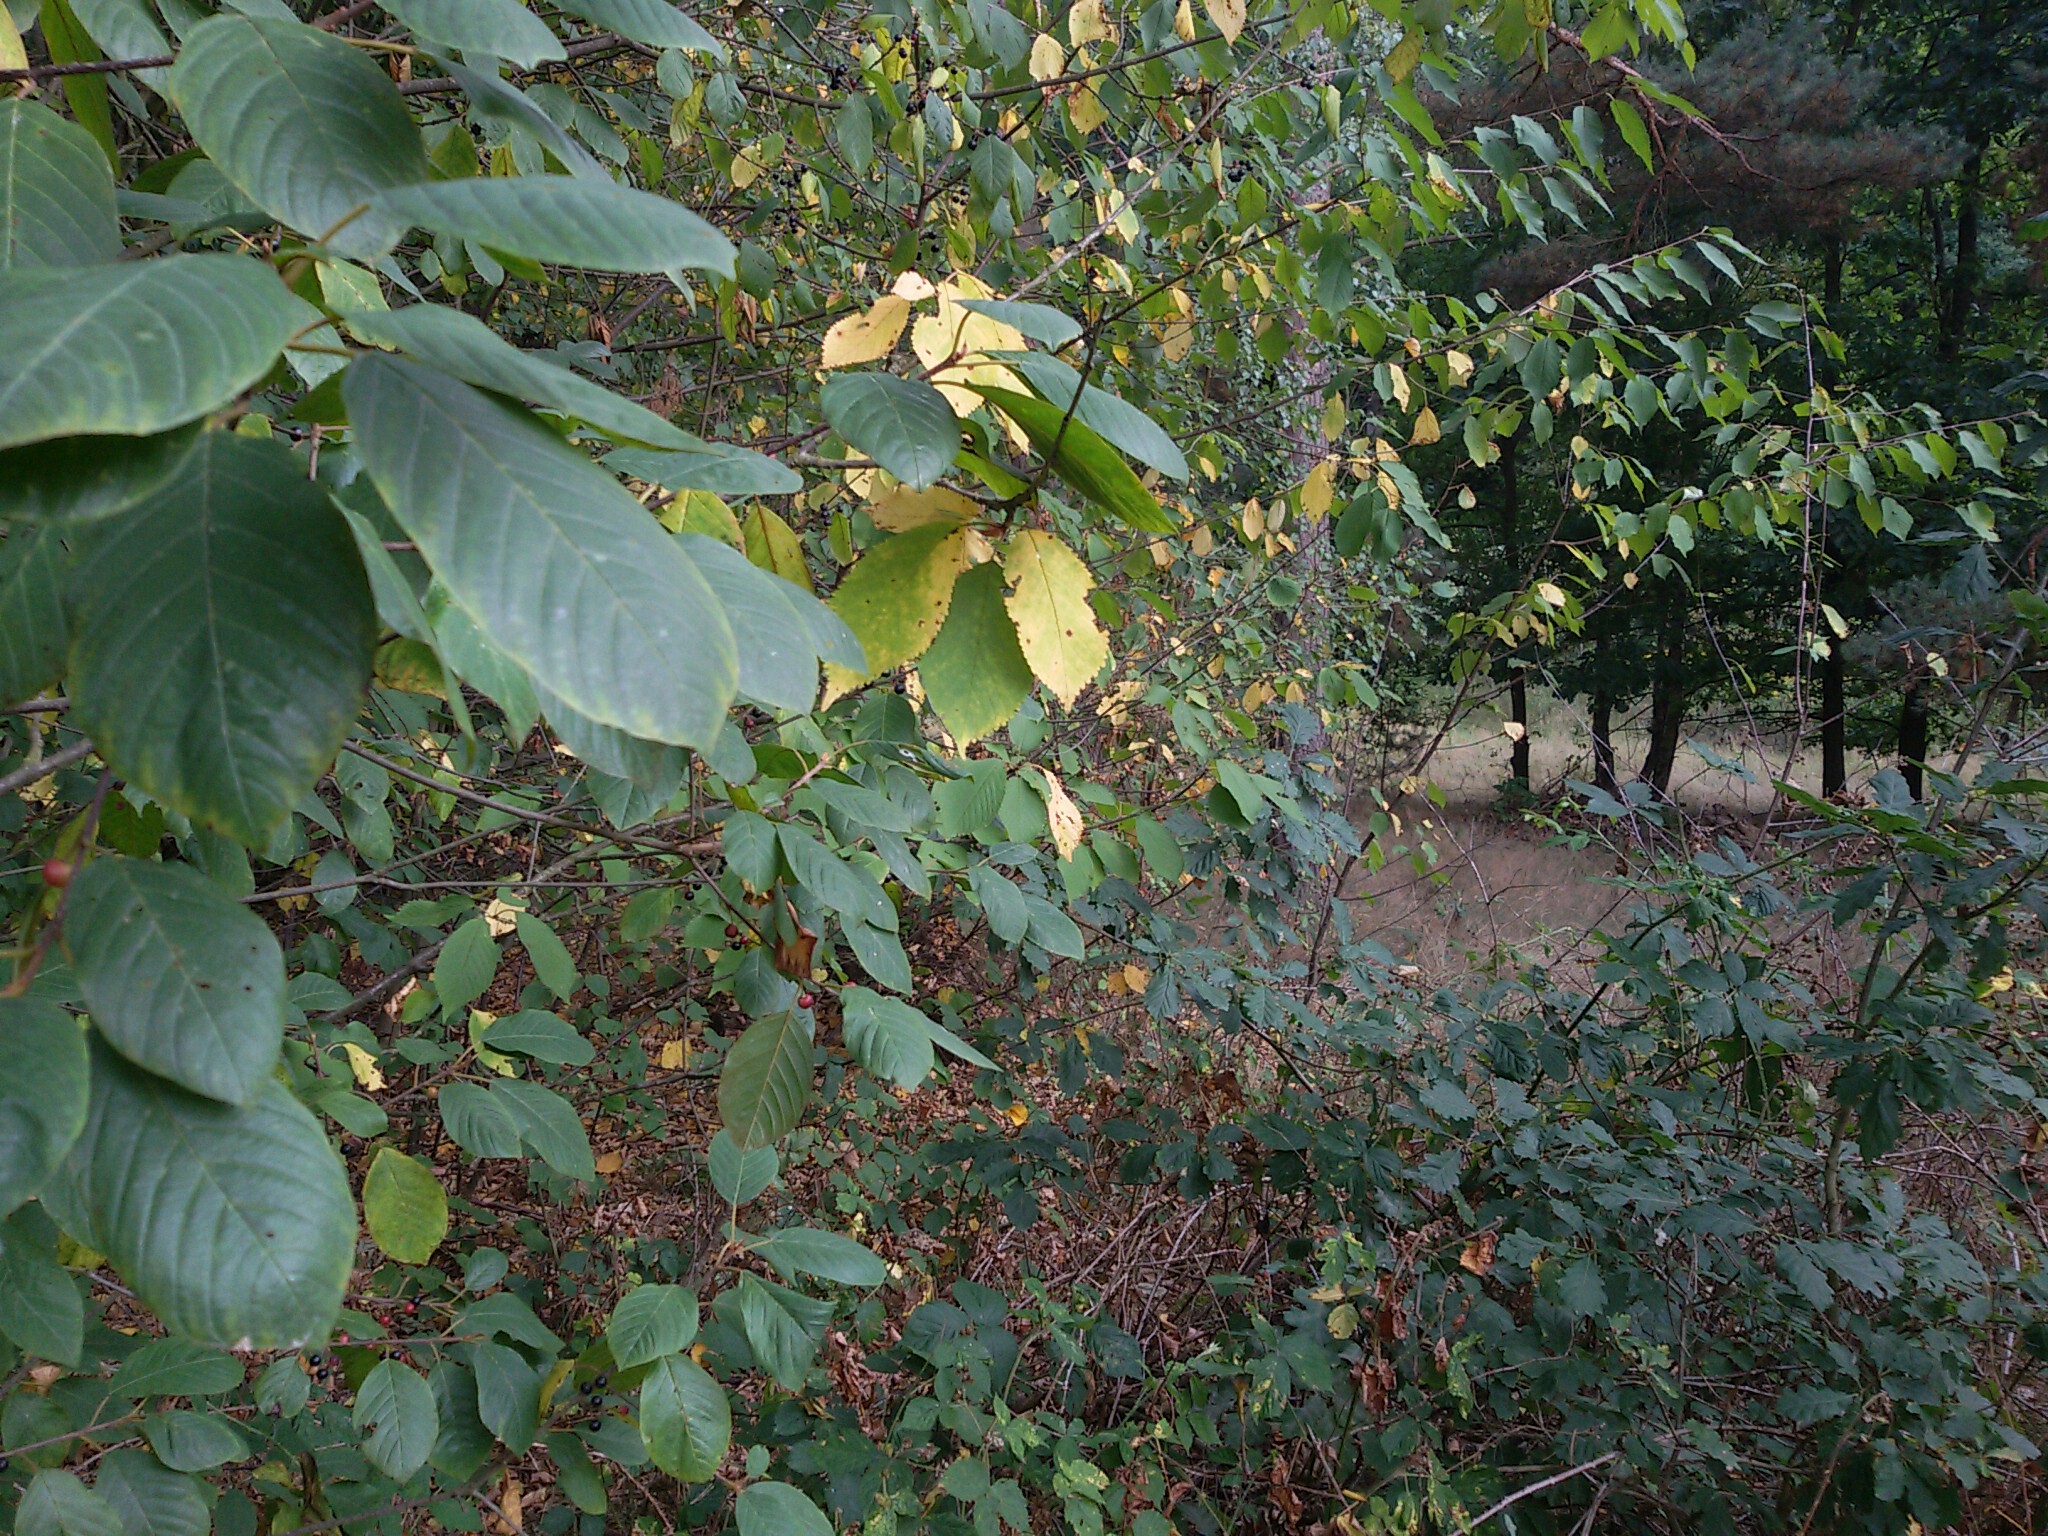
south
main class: Woodland
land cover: Broadleaved woodland
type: mesophytic deciduous forest
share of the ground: > 75 %
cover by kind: broadleaved forest trees 90 %, shrubs 5 %, herbaceous plants 5 %
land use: Forestry
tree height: < 5 m
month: August
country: PL
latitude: 51.1229
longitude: 15.7056
